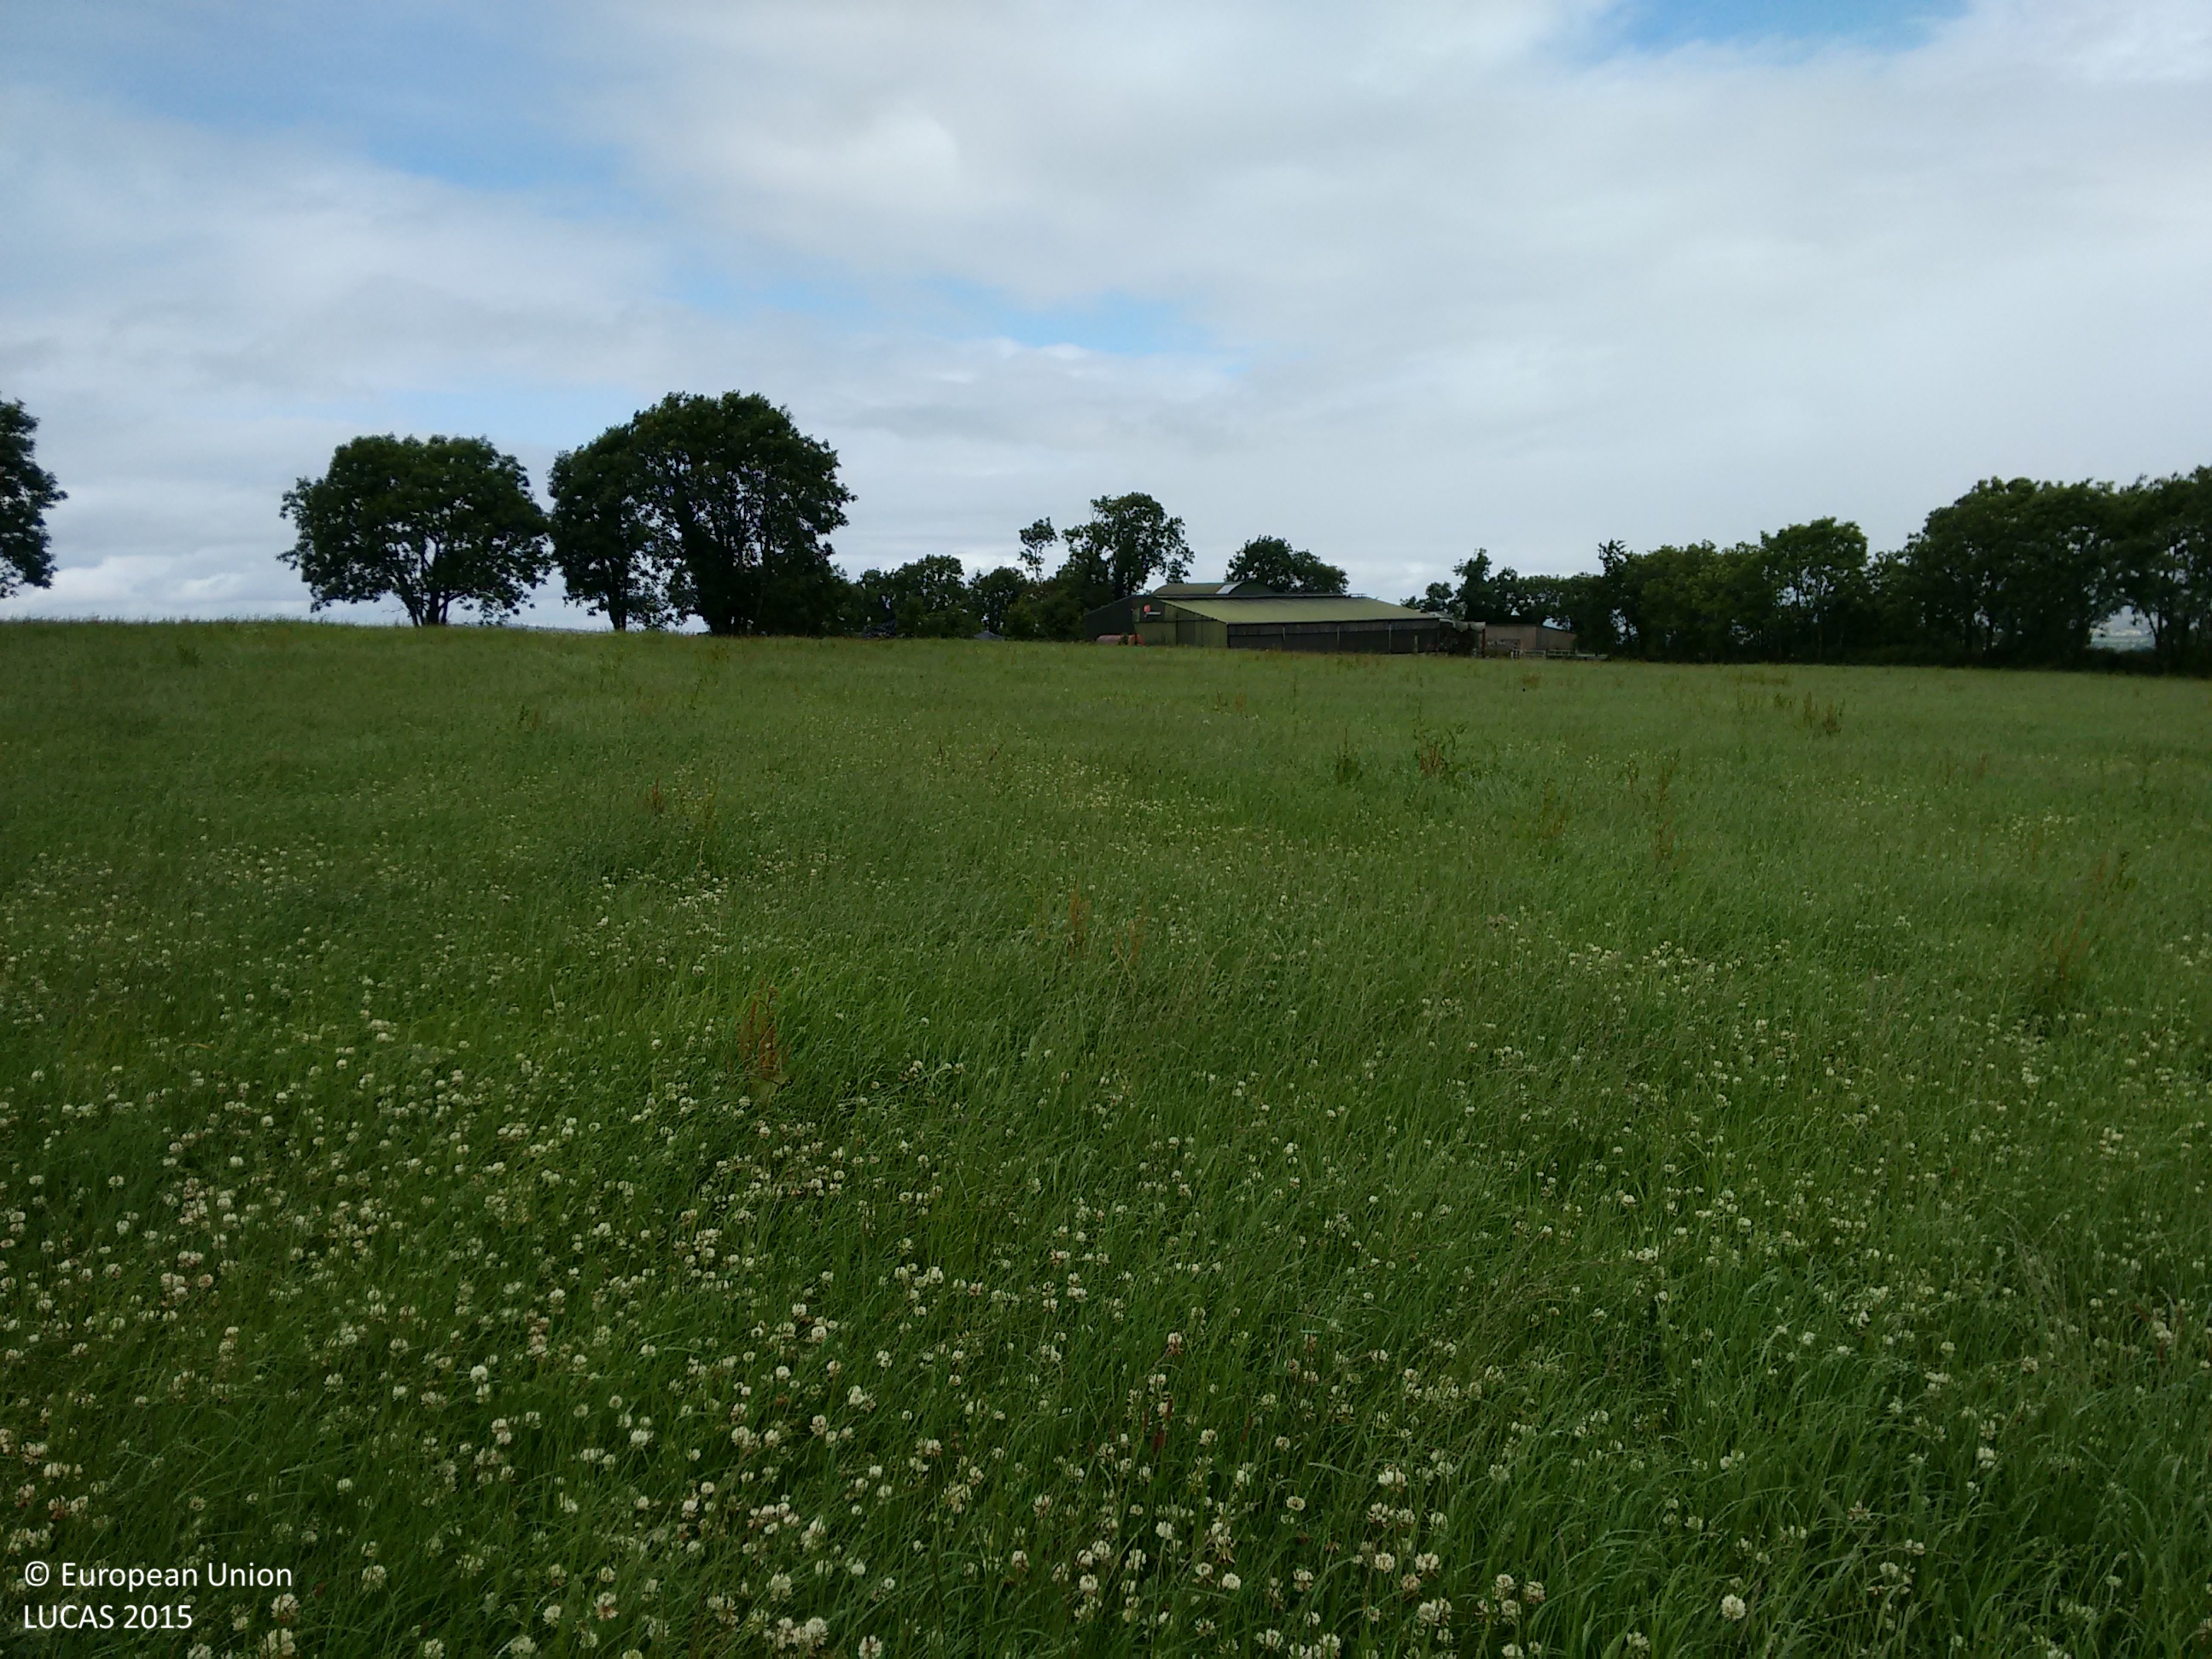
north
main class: Grassland
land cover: Grassland without tree/shrub cover
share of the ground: > 75 %
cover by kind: herbaceous plants 100 %
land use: Agriculture (excluding fallow land and kitchen gardens)
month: July
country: IE
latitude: 52.6863
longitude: -7.3591
